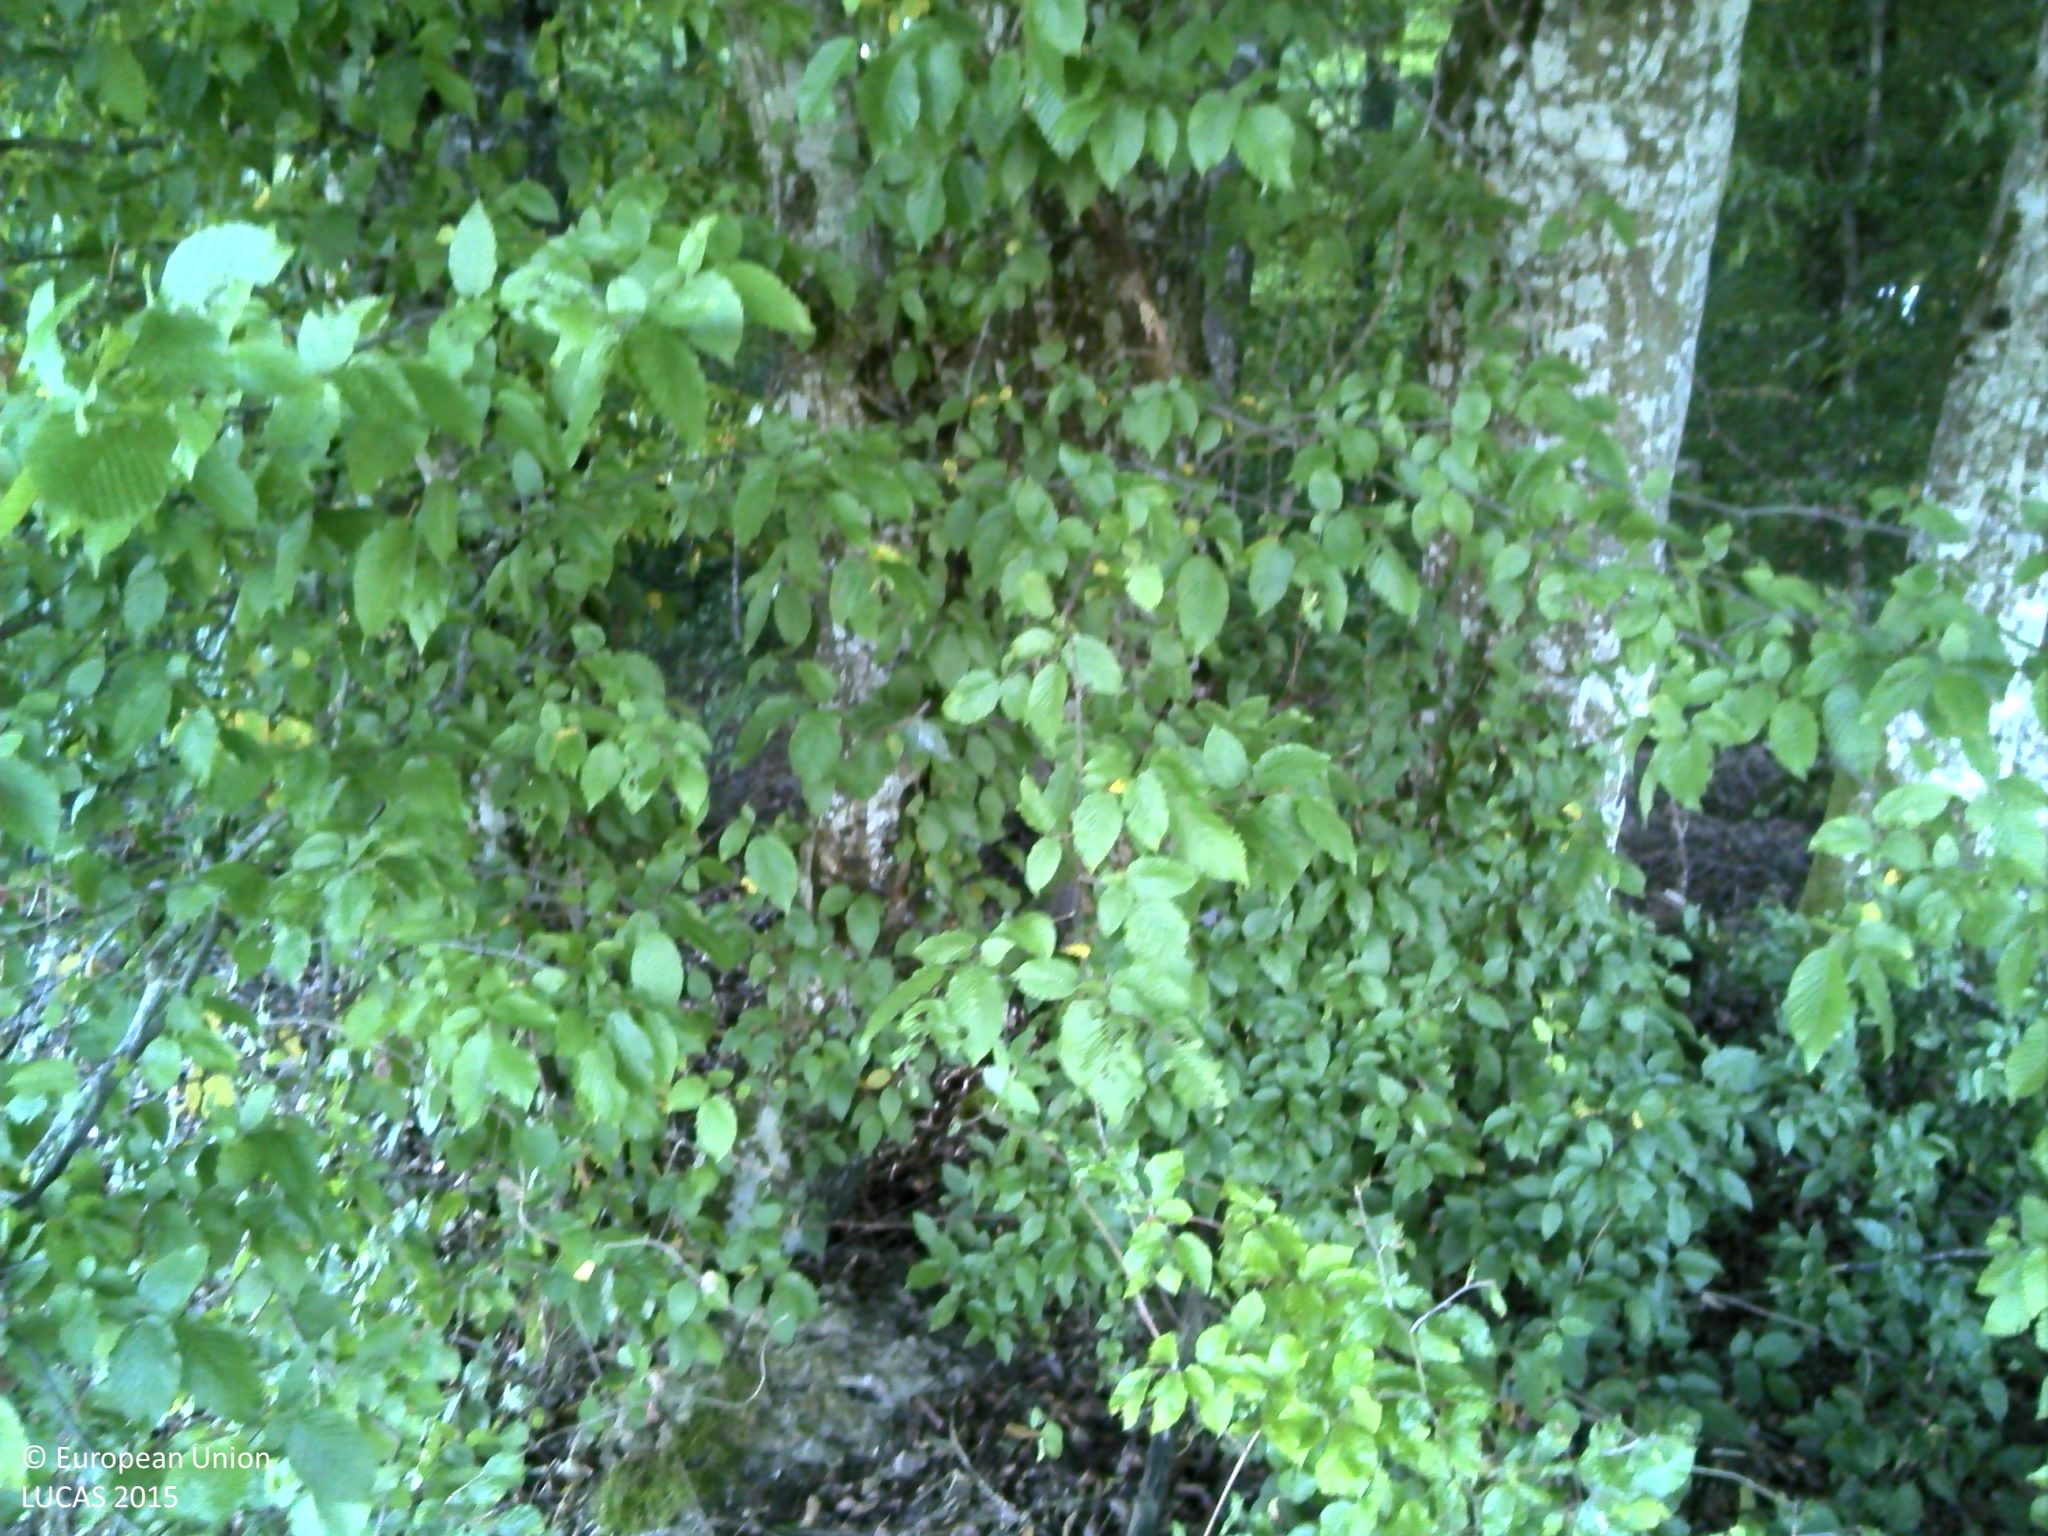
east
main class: Cropland
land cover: Oats
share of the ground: < 10 %
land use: Agriculture (excluding fallow land and kitchen gardens)
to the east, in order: Broadleaved woodland; Spruce dominated mixed woodland
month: July
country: FR
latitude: 48.0160
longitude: 6.2603
